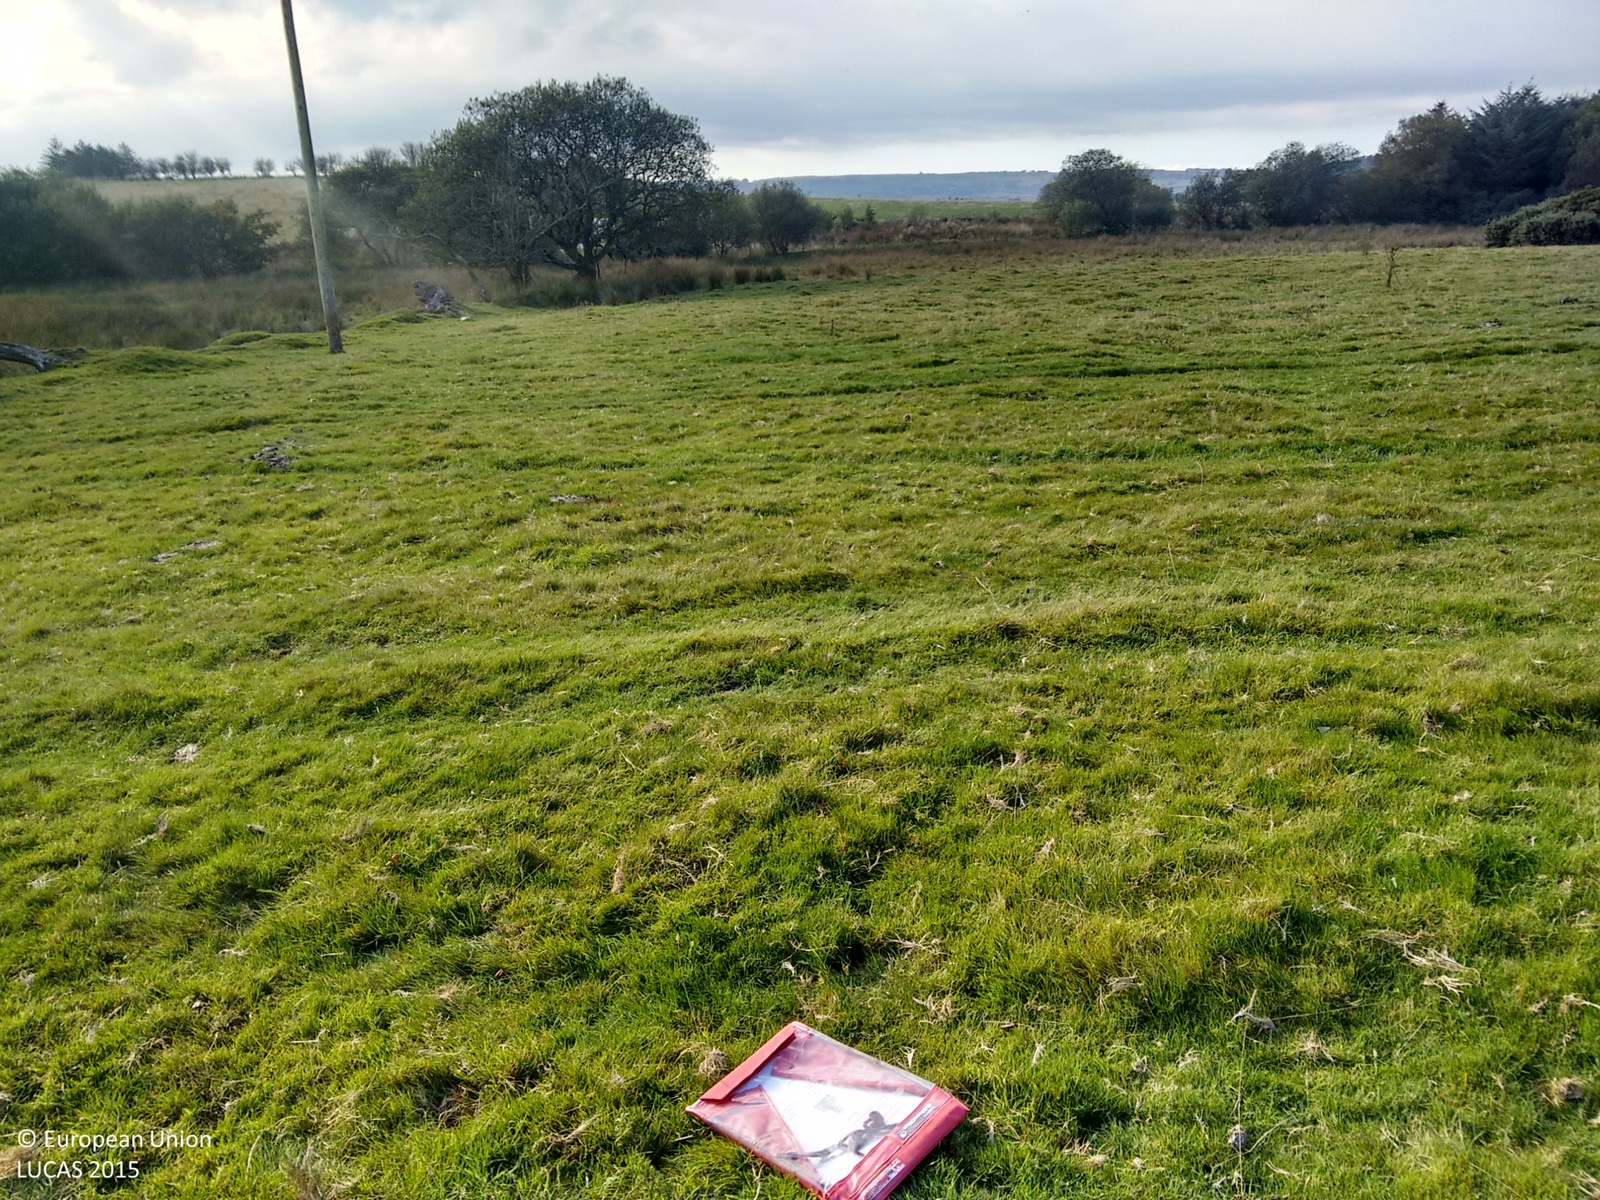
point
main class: Grassland
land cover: Grassland without tree/shrub cover
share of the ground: > 75 %
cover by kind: herbaceous plants 100 %
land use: Agriculture (excluding fallow land and kitchen gardens)
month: October
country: GB
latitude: 52.2793
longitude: -3.9446
